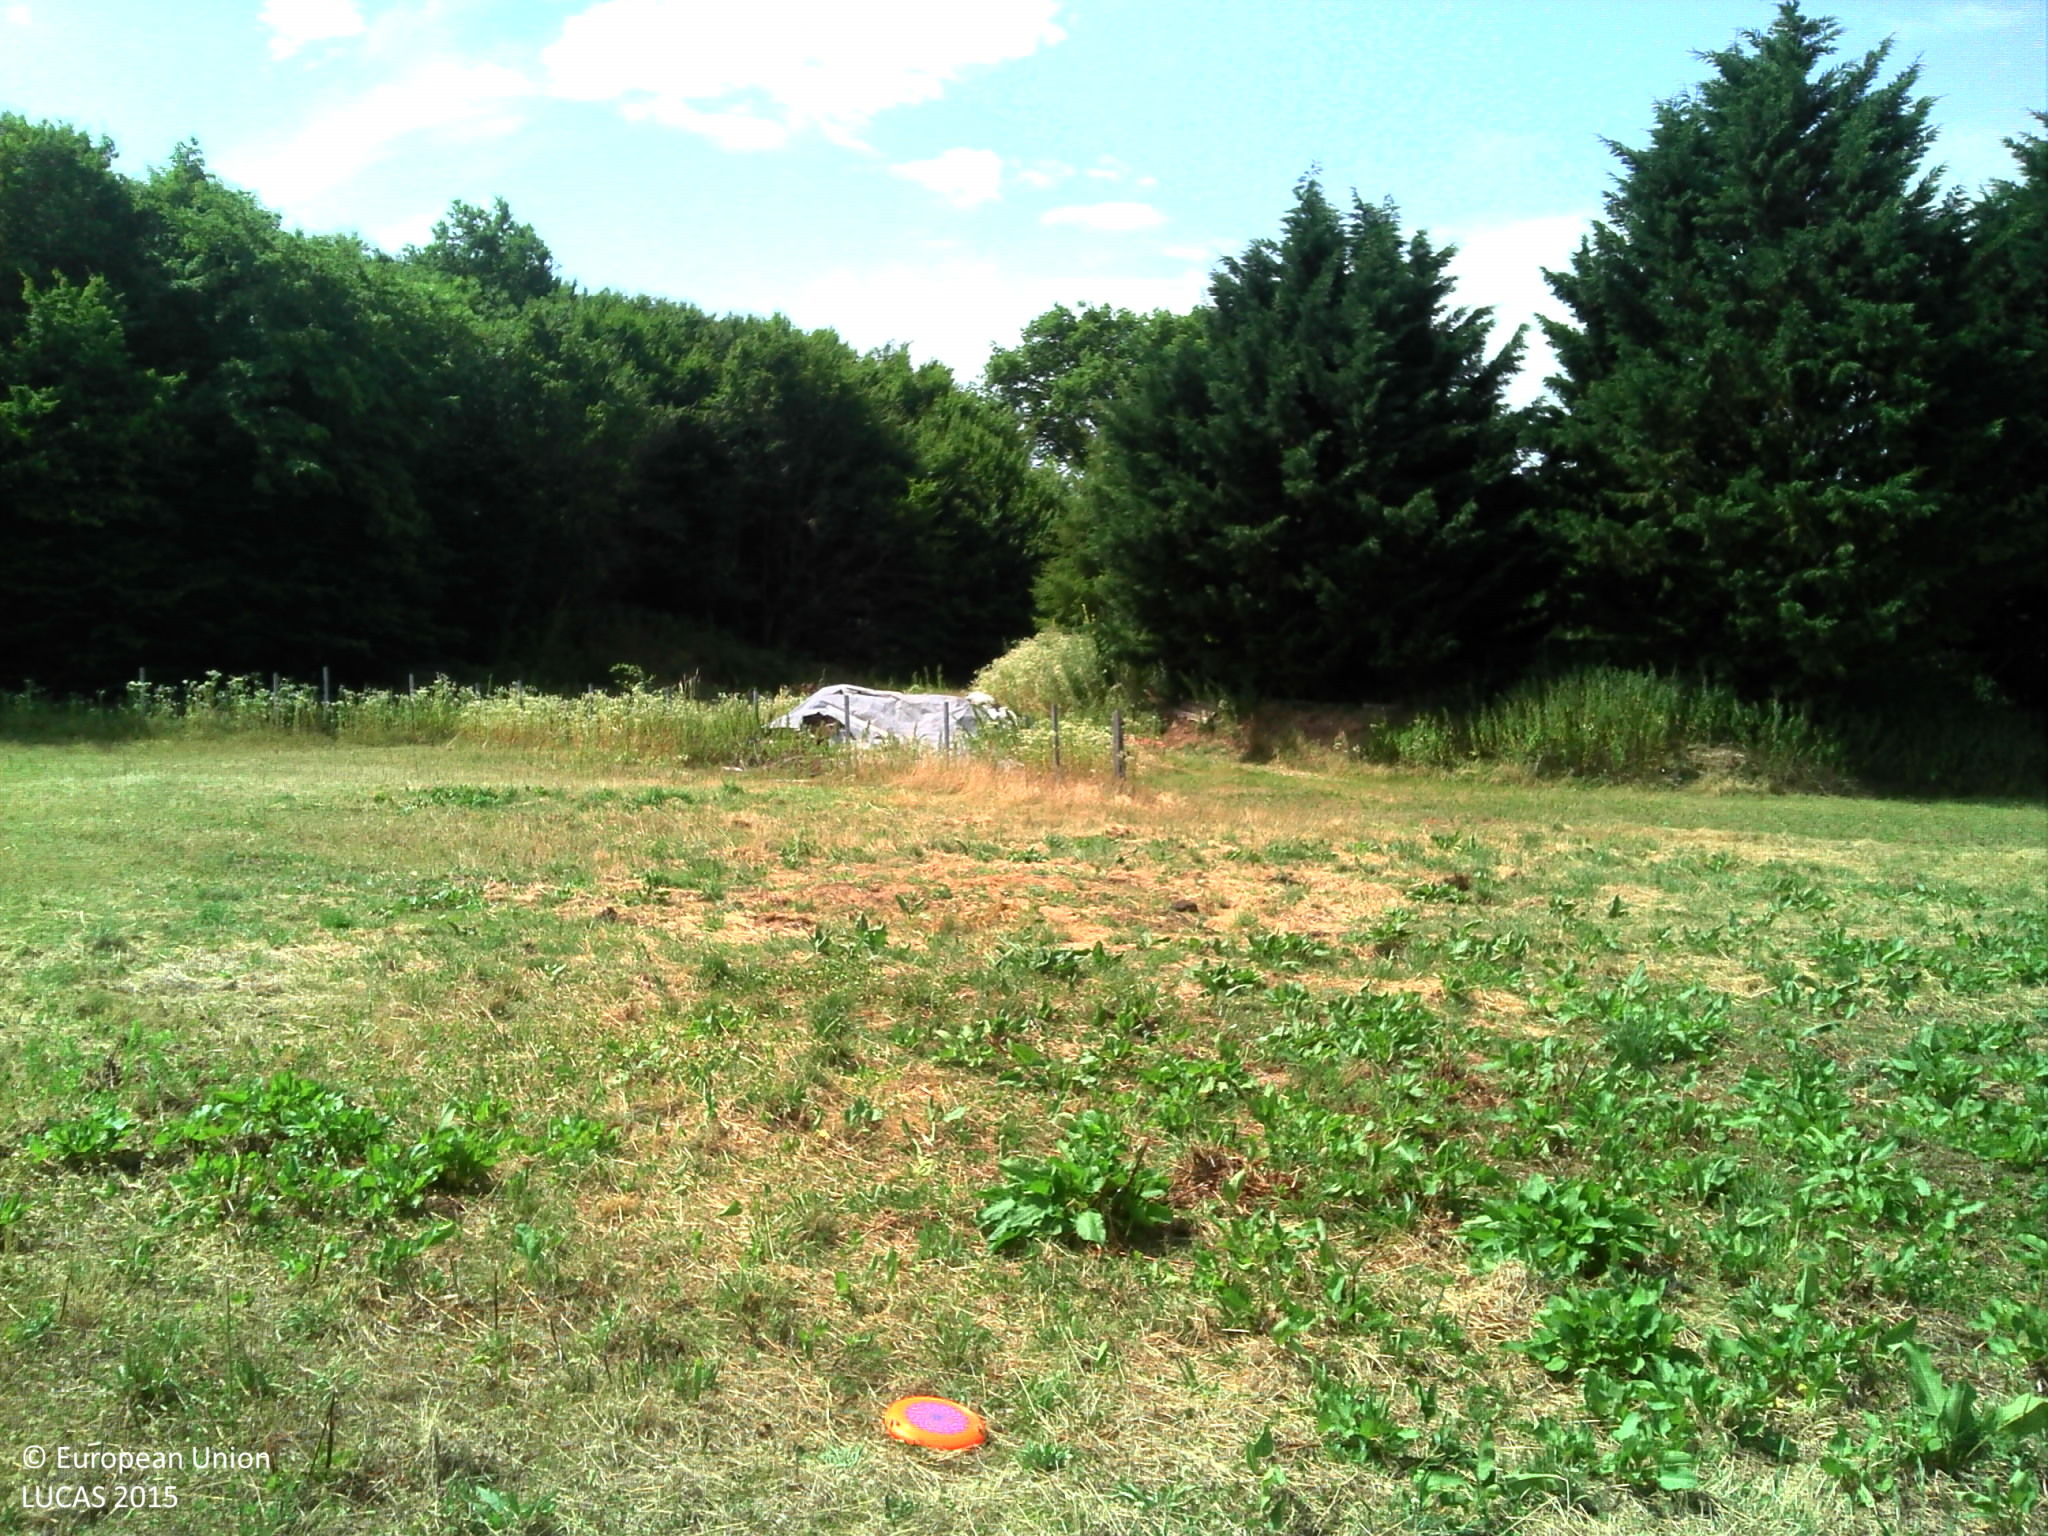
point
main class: Grassland
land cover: Grassland without tree/shrub cover
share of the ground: > 75 %
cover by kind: herbaceous plants 100 %
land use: Agriculture (excluding fallow land and kitchen gardens)
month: July
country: FR
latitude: 45.6927
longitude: 5.3941
